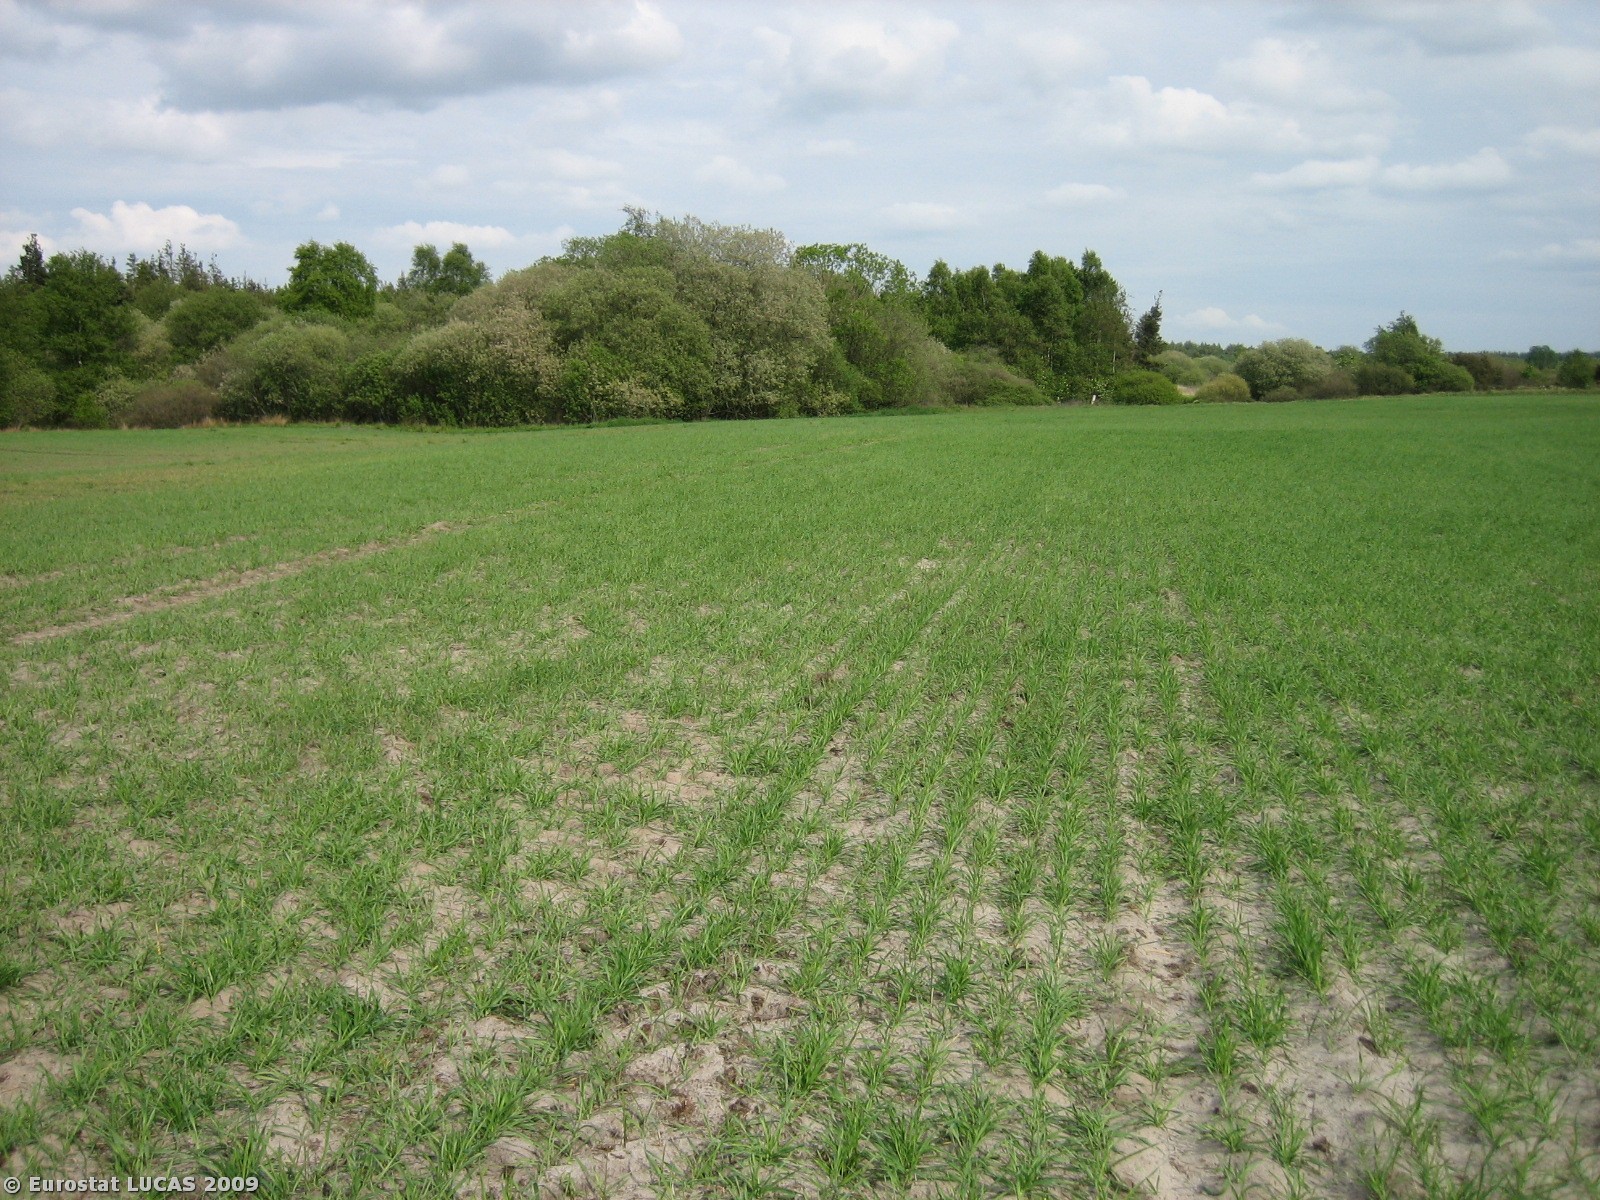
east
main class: Cropland
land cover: Barley
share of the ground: 25 - 50 %
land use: Agriculture (excluding fallow land and kitchen gardens)
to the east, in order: Barley; Broadleaved woodland; Grassland without tree/shrub cover; Inland running water; Coniferous woodland; Broadleaved woodland; Grass margins; Inland running water
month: May
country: DK
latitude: 56.2213
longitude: 9.2107
